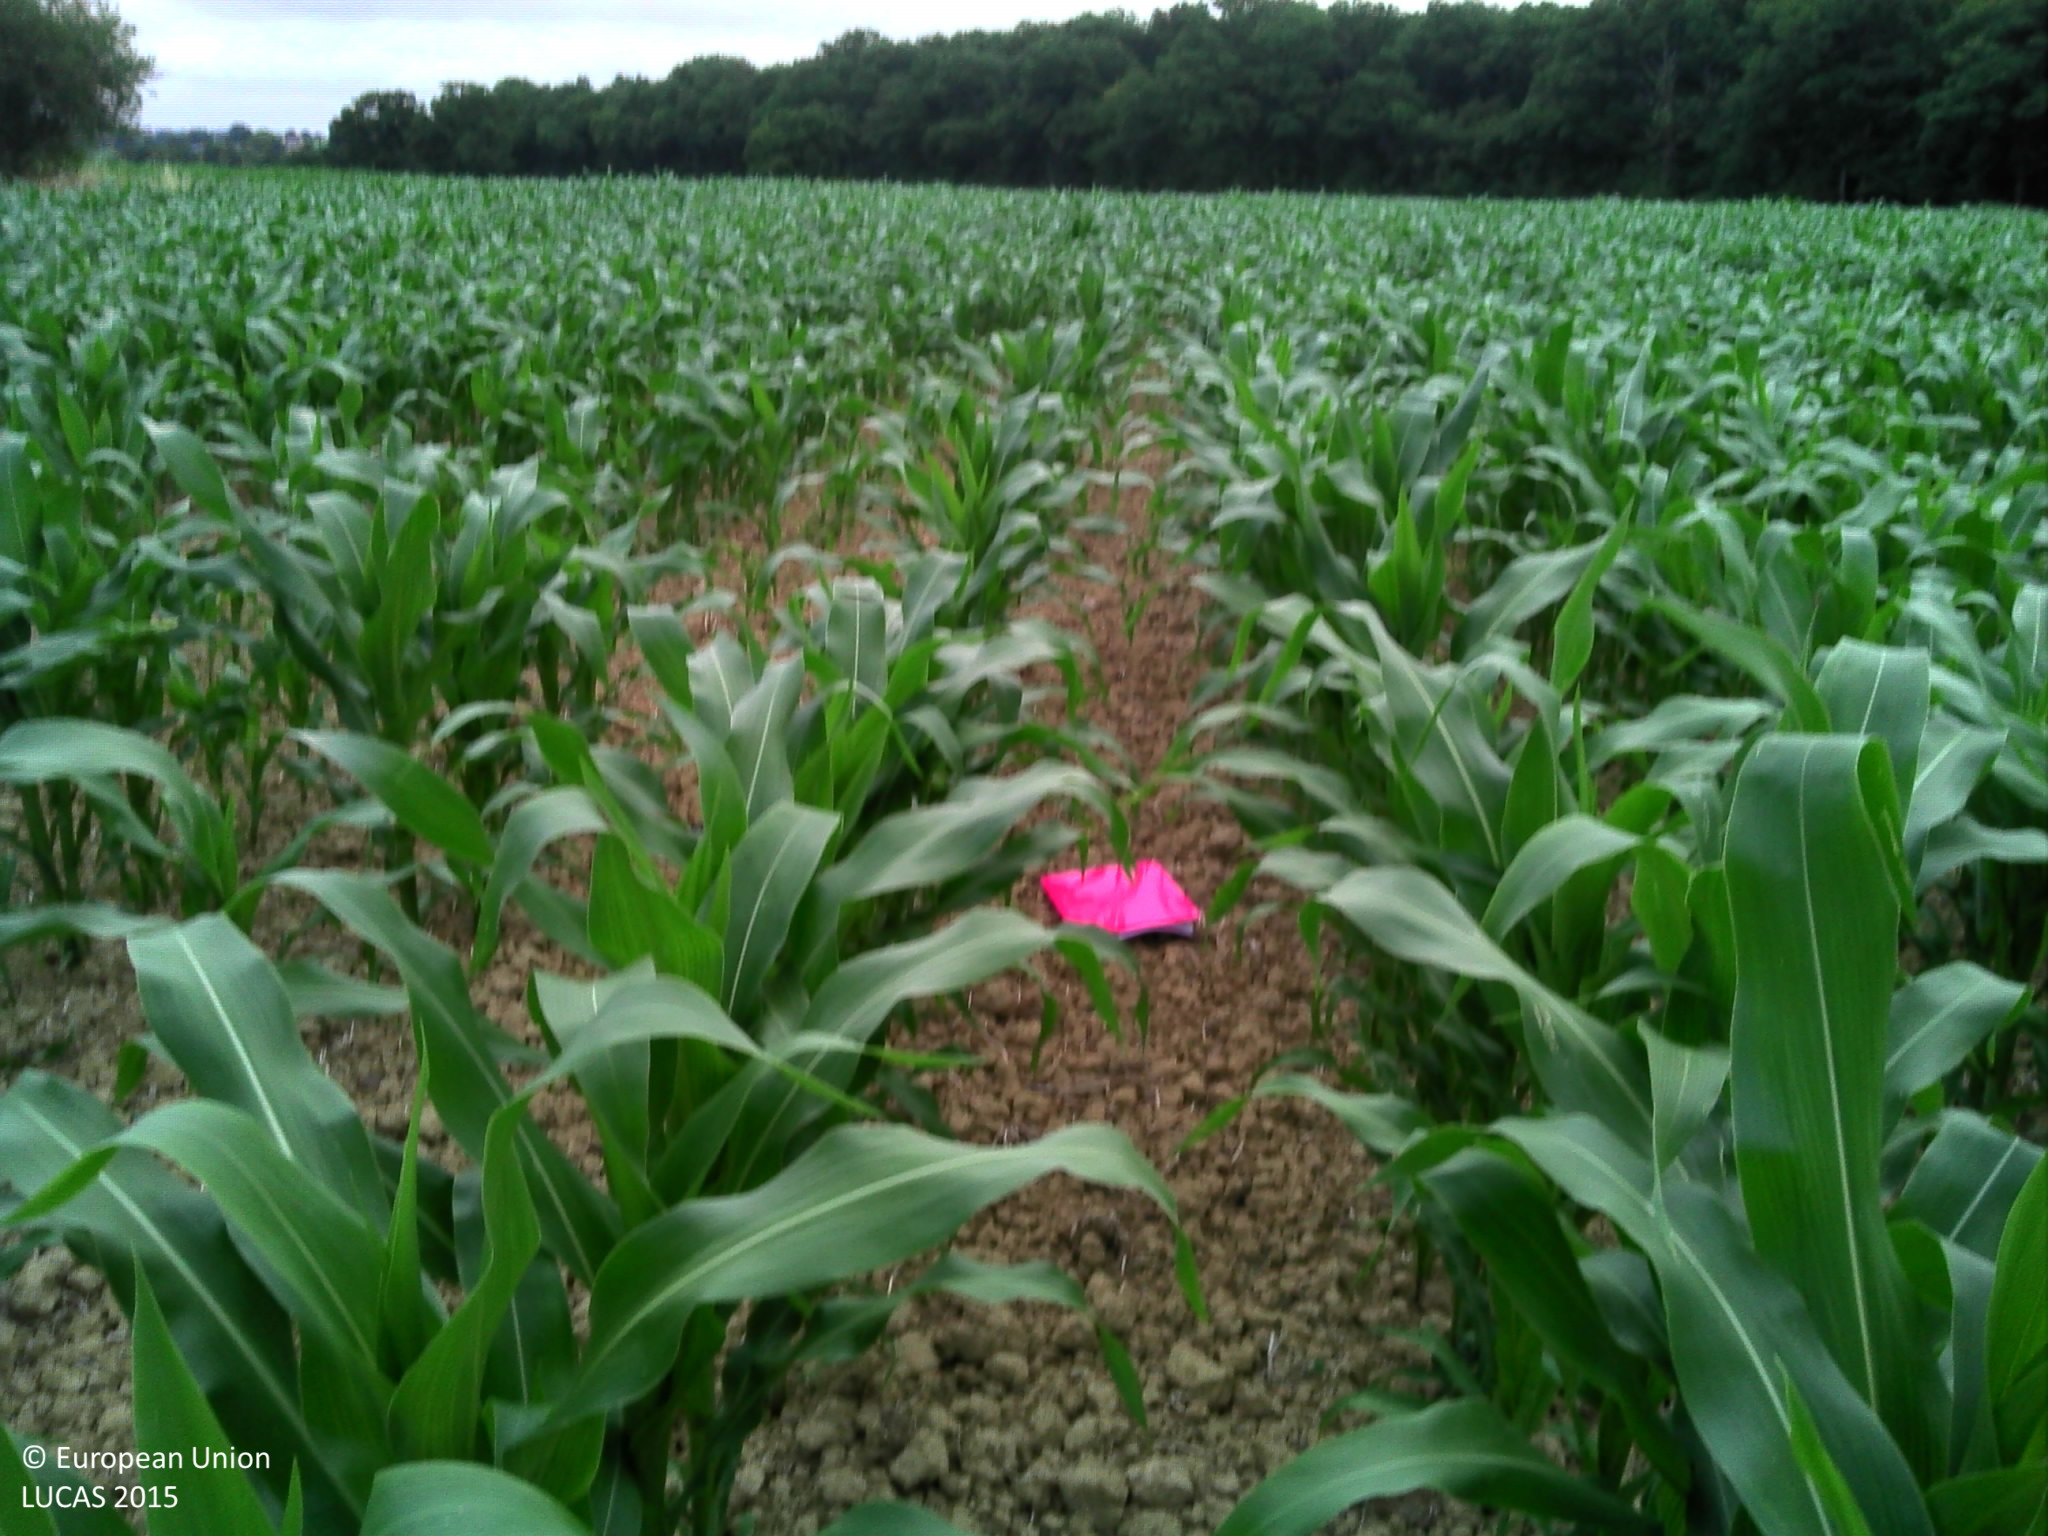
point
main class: Cropland
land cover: Maize
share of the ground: 25 - 50 %
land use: Agriculture (excluding fallow land and kitchen gardens)
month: July
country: FR
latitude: 47.8465
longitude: -1.4153
